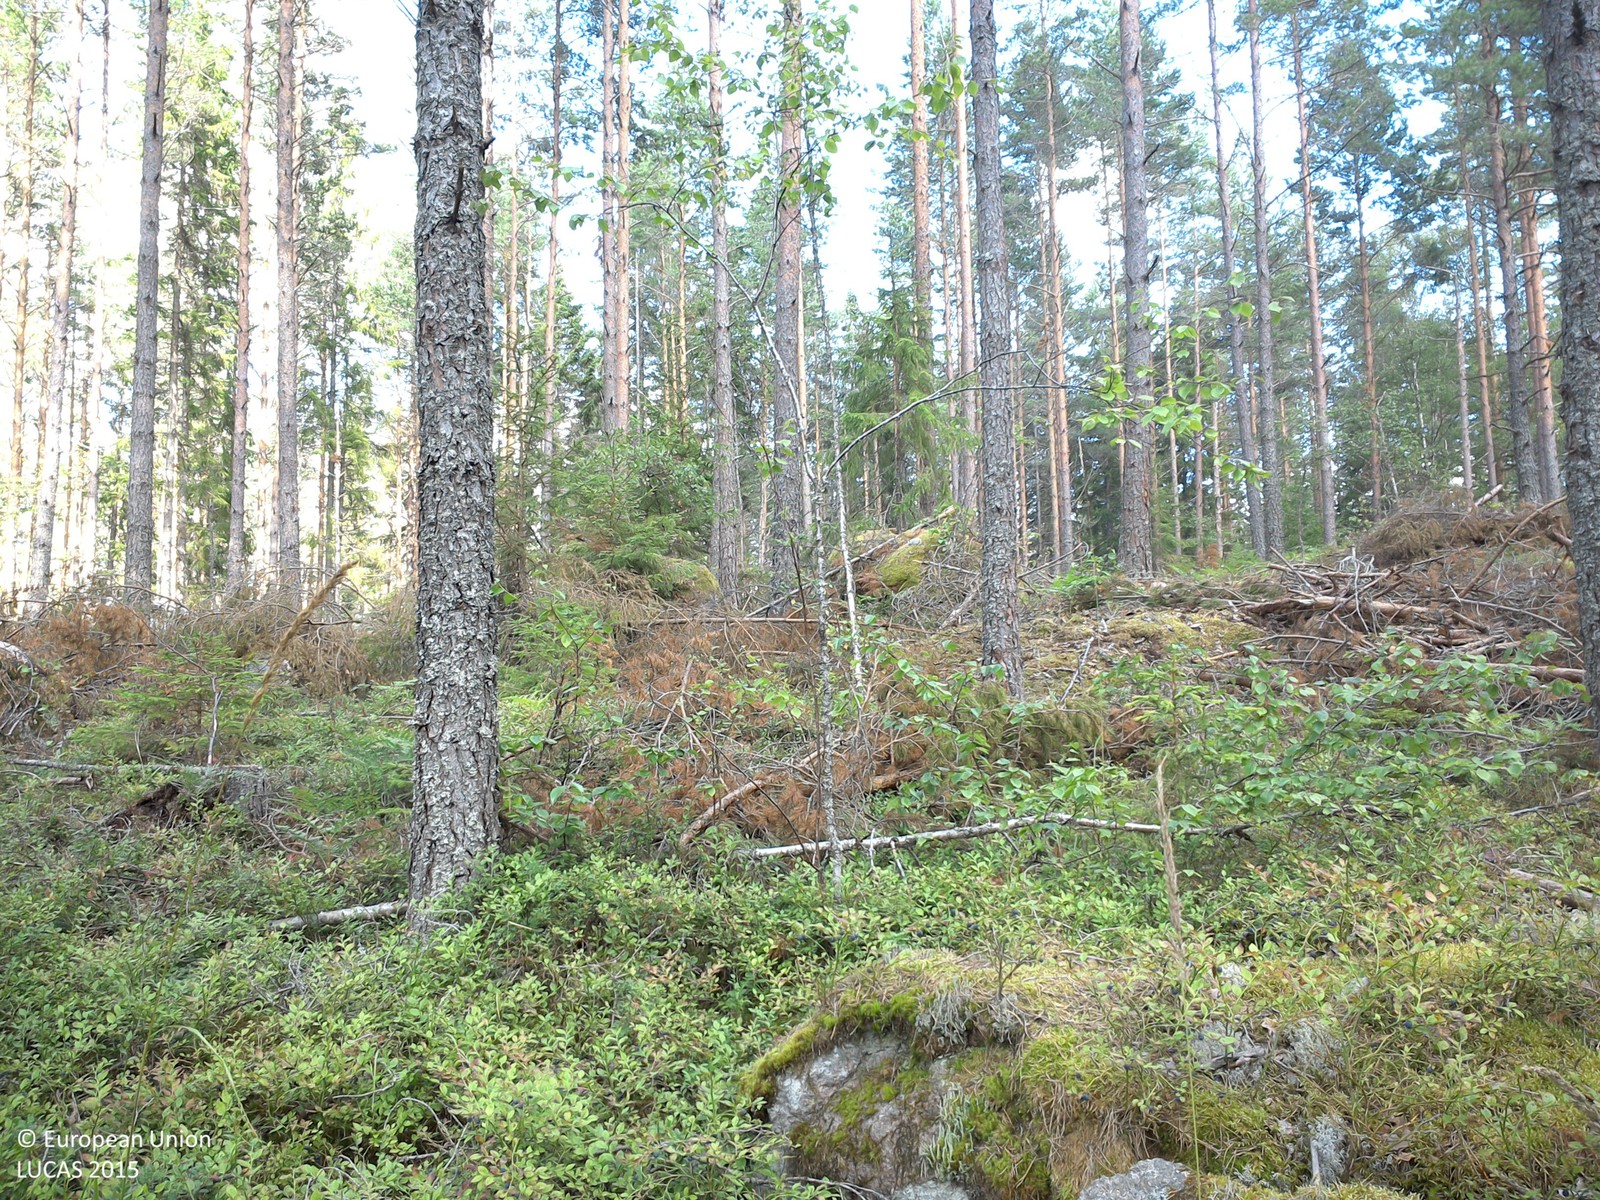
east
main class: Woodland
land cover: Pine dominated coniferous woodland
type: boreal forest
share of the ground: 25 - 50 %
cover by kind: herbaceous plants 65 %, coniferous forest trees 30 %, lichens and mosses 5 %
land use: Forestry
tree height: > 5 m
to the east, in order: Pine dominated coniferous woodland; Grassland with sparse tree/shrub cover; Pine dominated coniferous woodland; Grassland with sparse tree/shrub cover
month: August
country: SE
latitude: 58.1479
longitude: 15.3806
